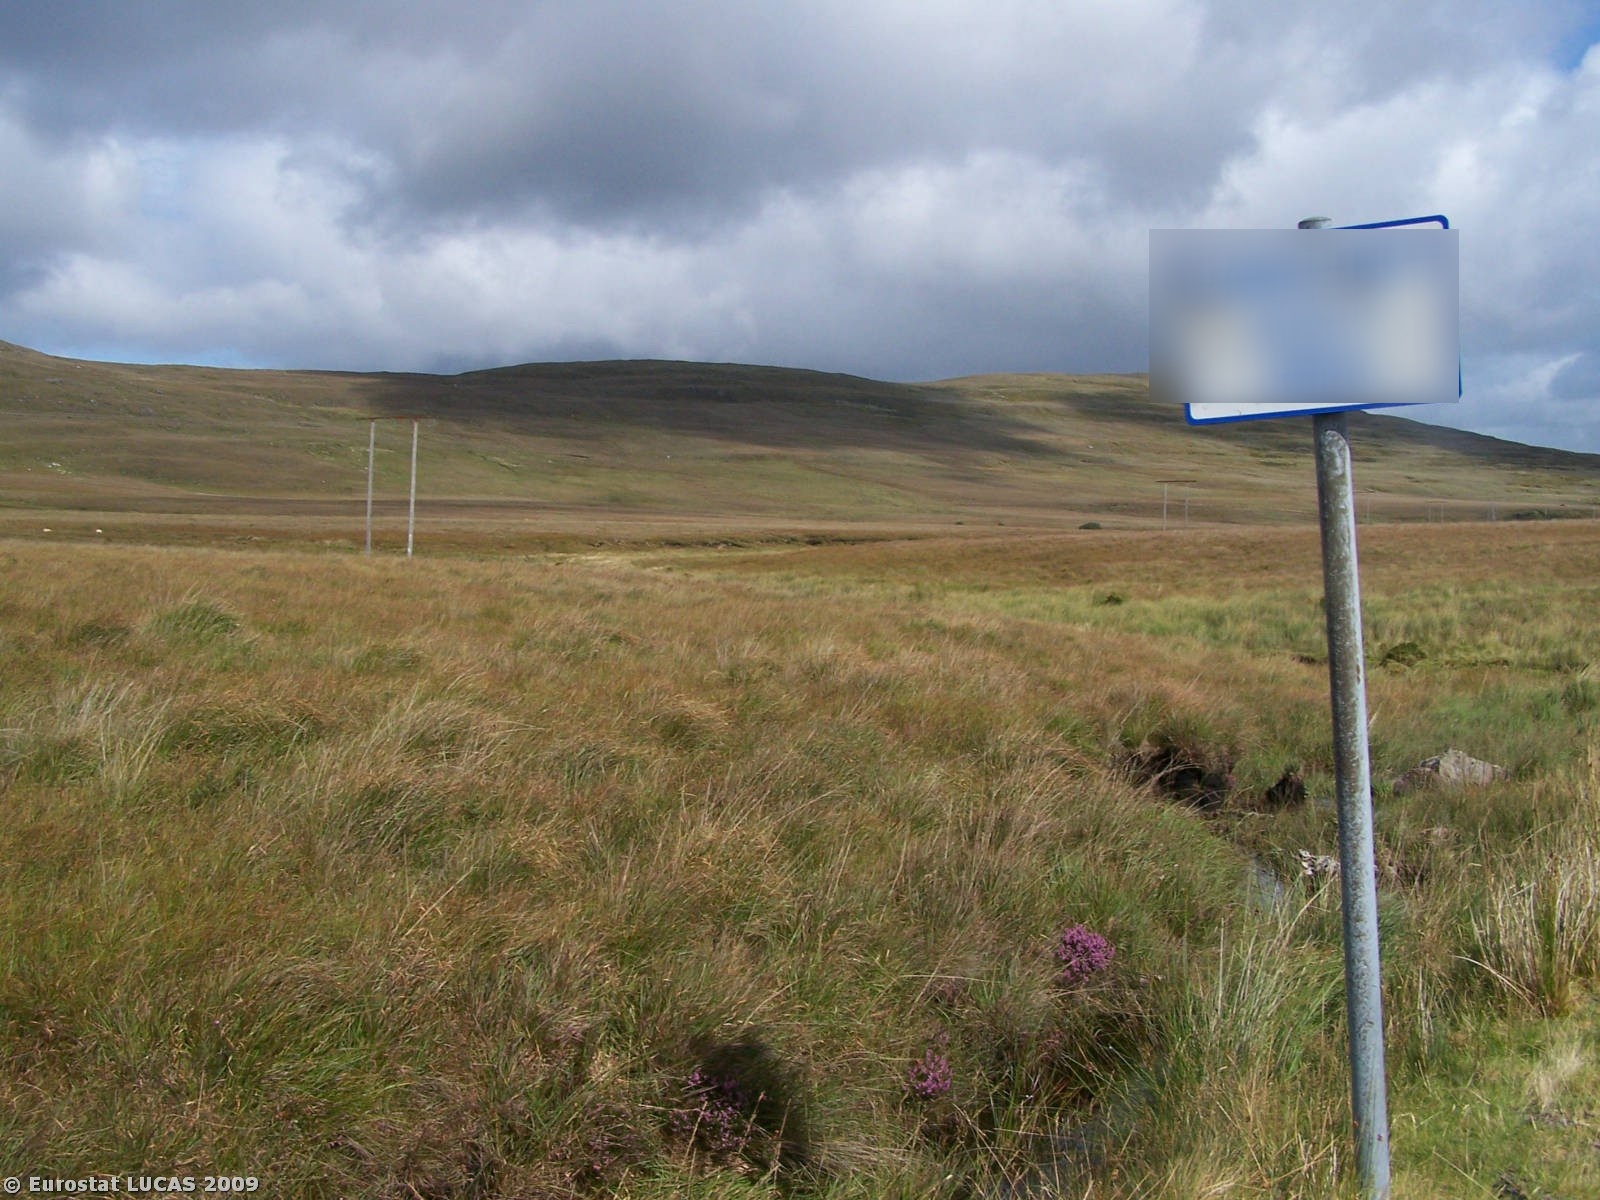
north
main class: Wetlands
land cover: Peatbogs
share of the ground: > 75 %
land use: Mining and quarrying
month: September
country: IE
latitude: 51.9631
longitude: -9.9125
